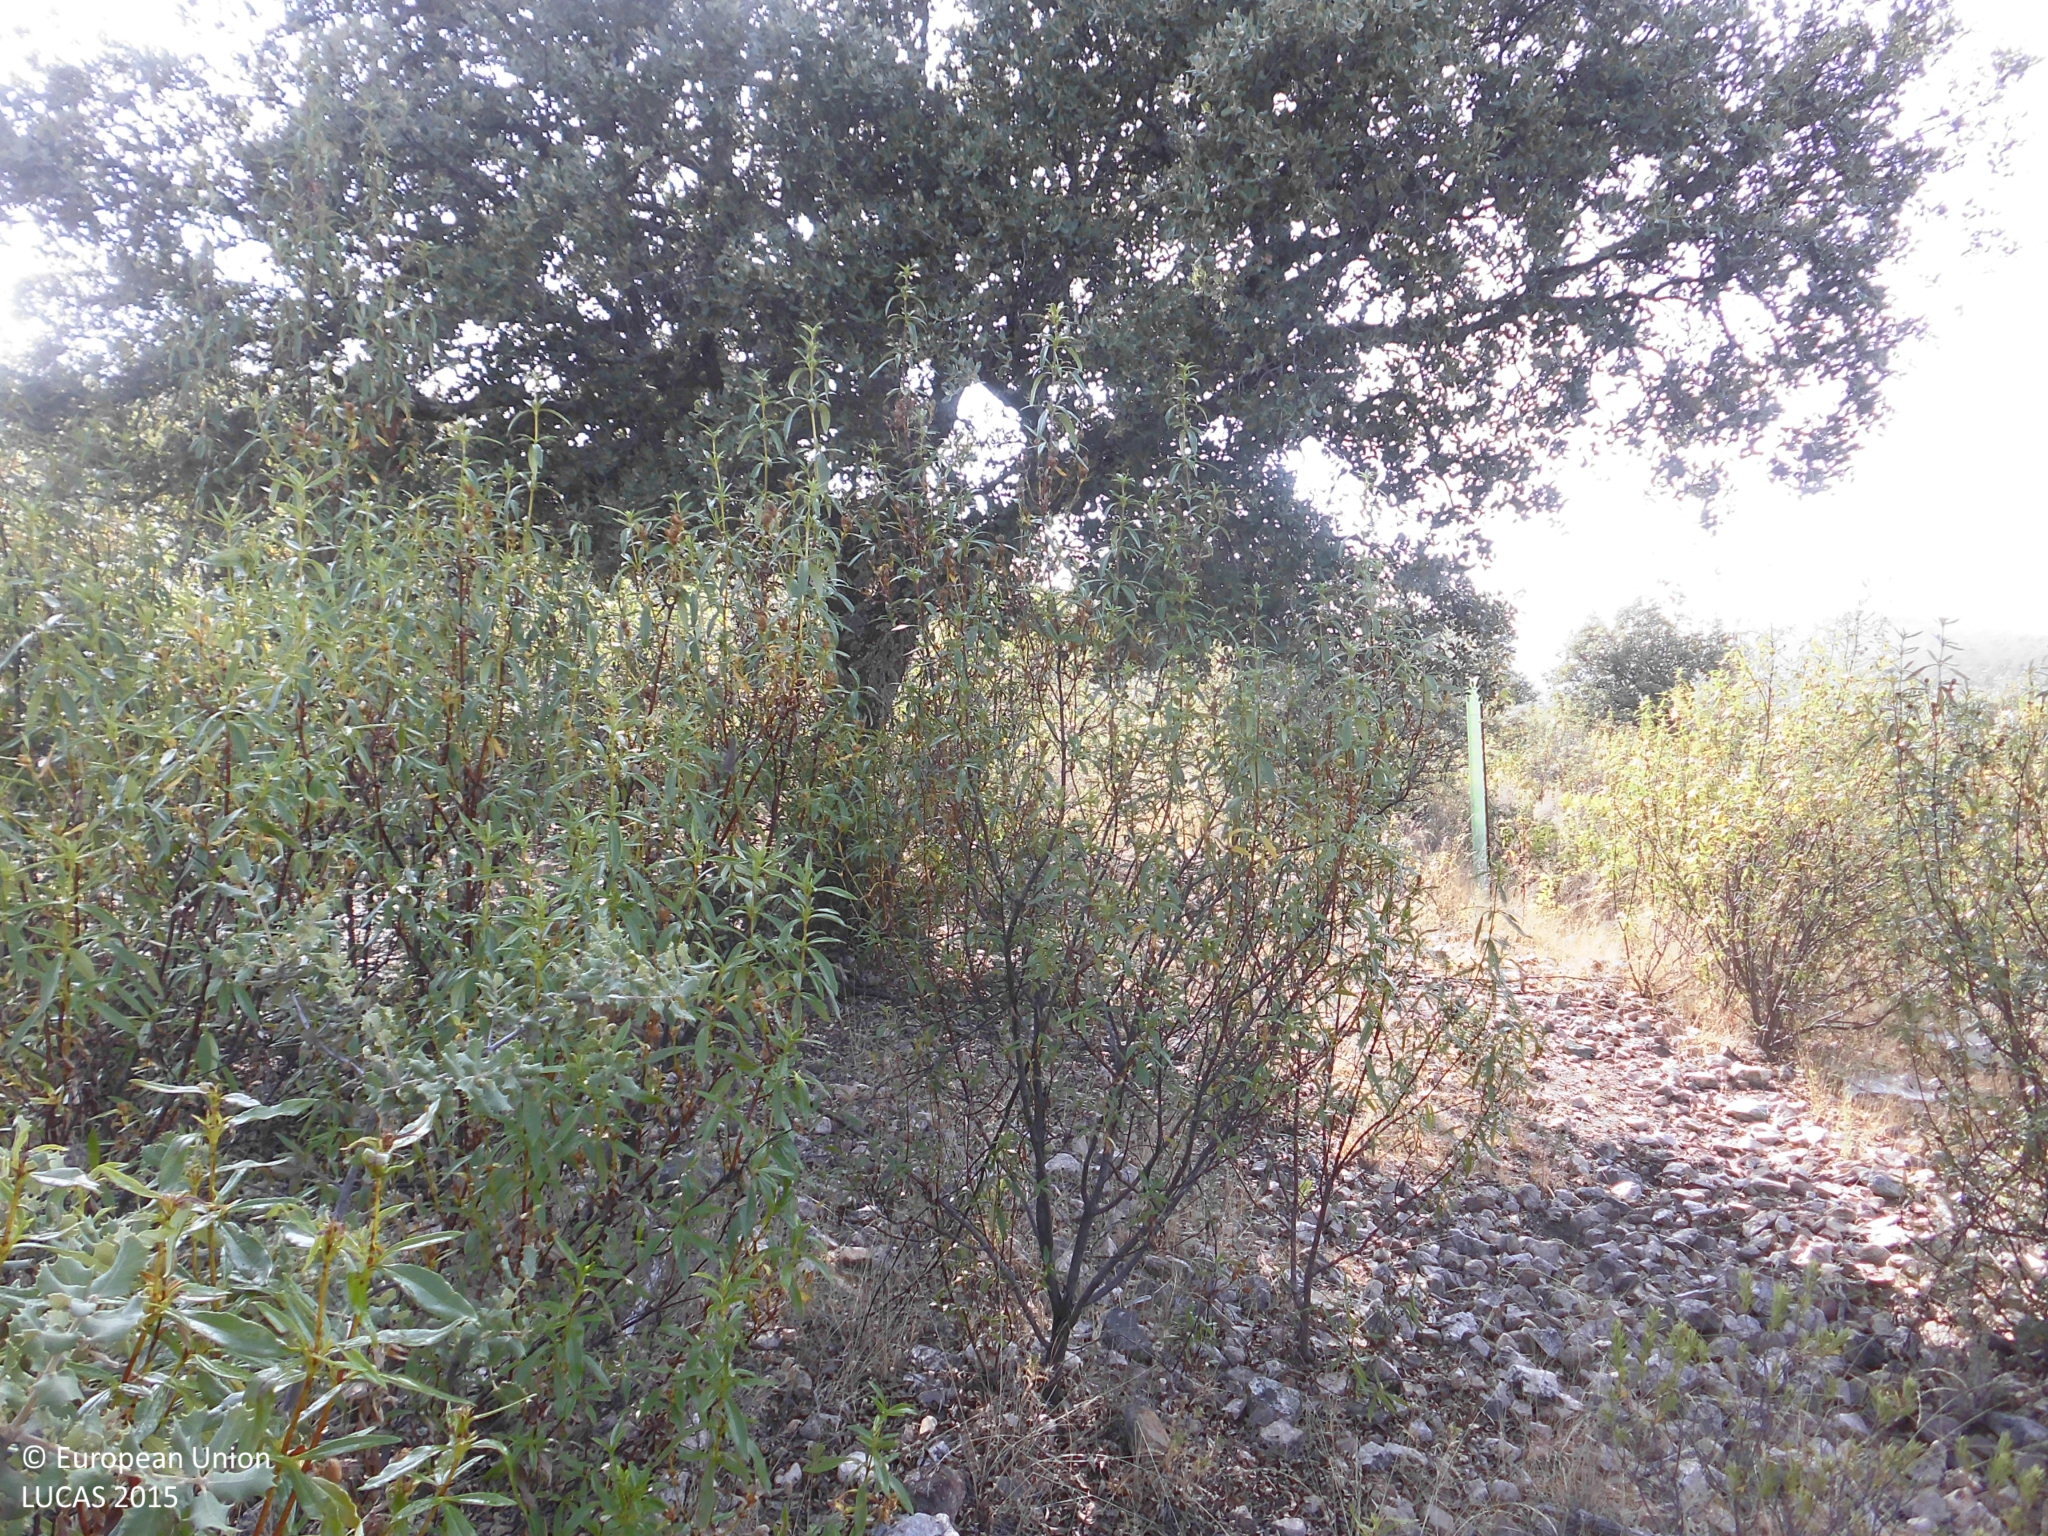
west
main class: Shrubland
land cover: Shrubland with sparse tree cover
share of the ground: > 75 %
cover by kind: shrubs 90 %, broadleaved forest trees 5 %, herbaceous plants 5 %
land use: Forestry
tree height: > 5 m
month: July
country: ES
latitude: 39.6520
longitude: -5.6150
